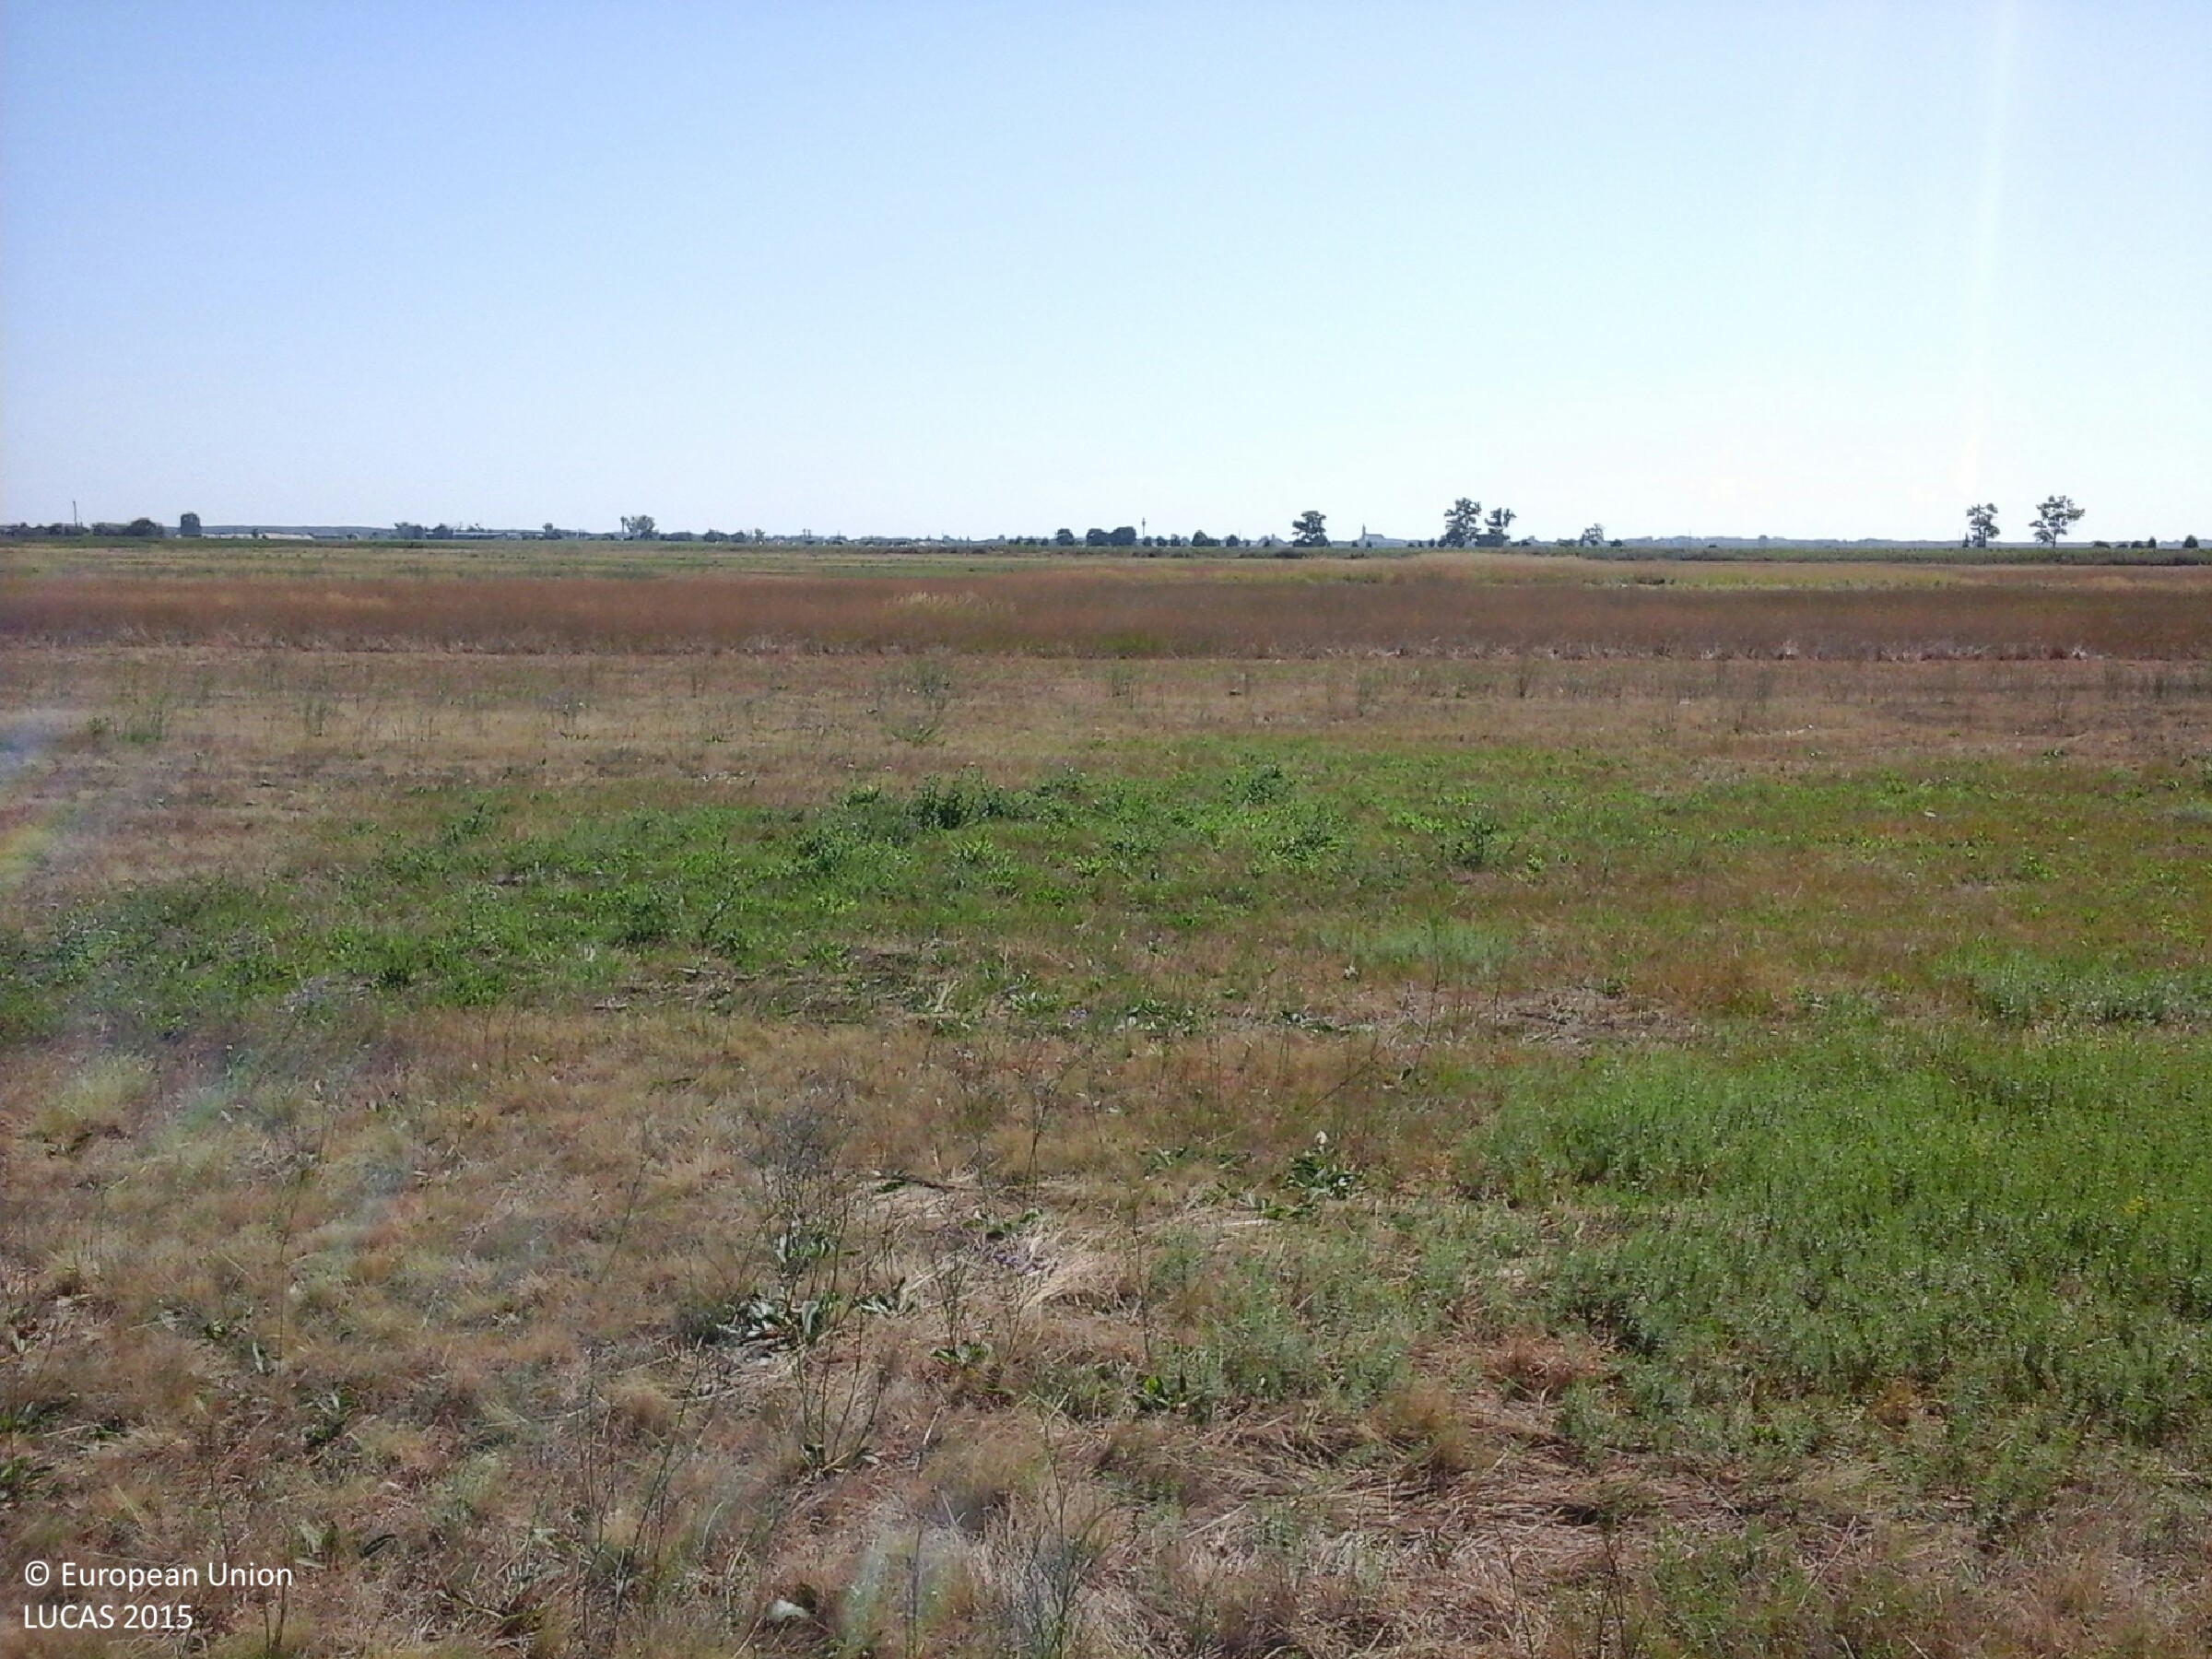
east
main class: Grassland
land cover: Grassland without tree/shrub cover
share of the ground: > 75 %
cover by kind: herbaceous plants 100 %
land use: Agriculture (excluding fallow land and kitchen gardens)
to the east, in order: Grassland without tree/shrub cover
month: July
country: HU
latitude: 47.5888
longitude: 20.5504
